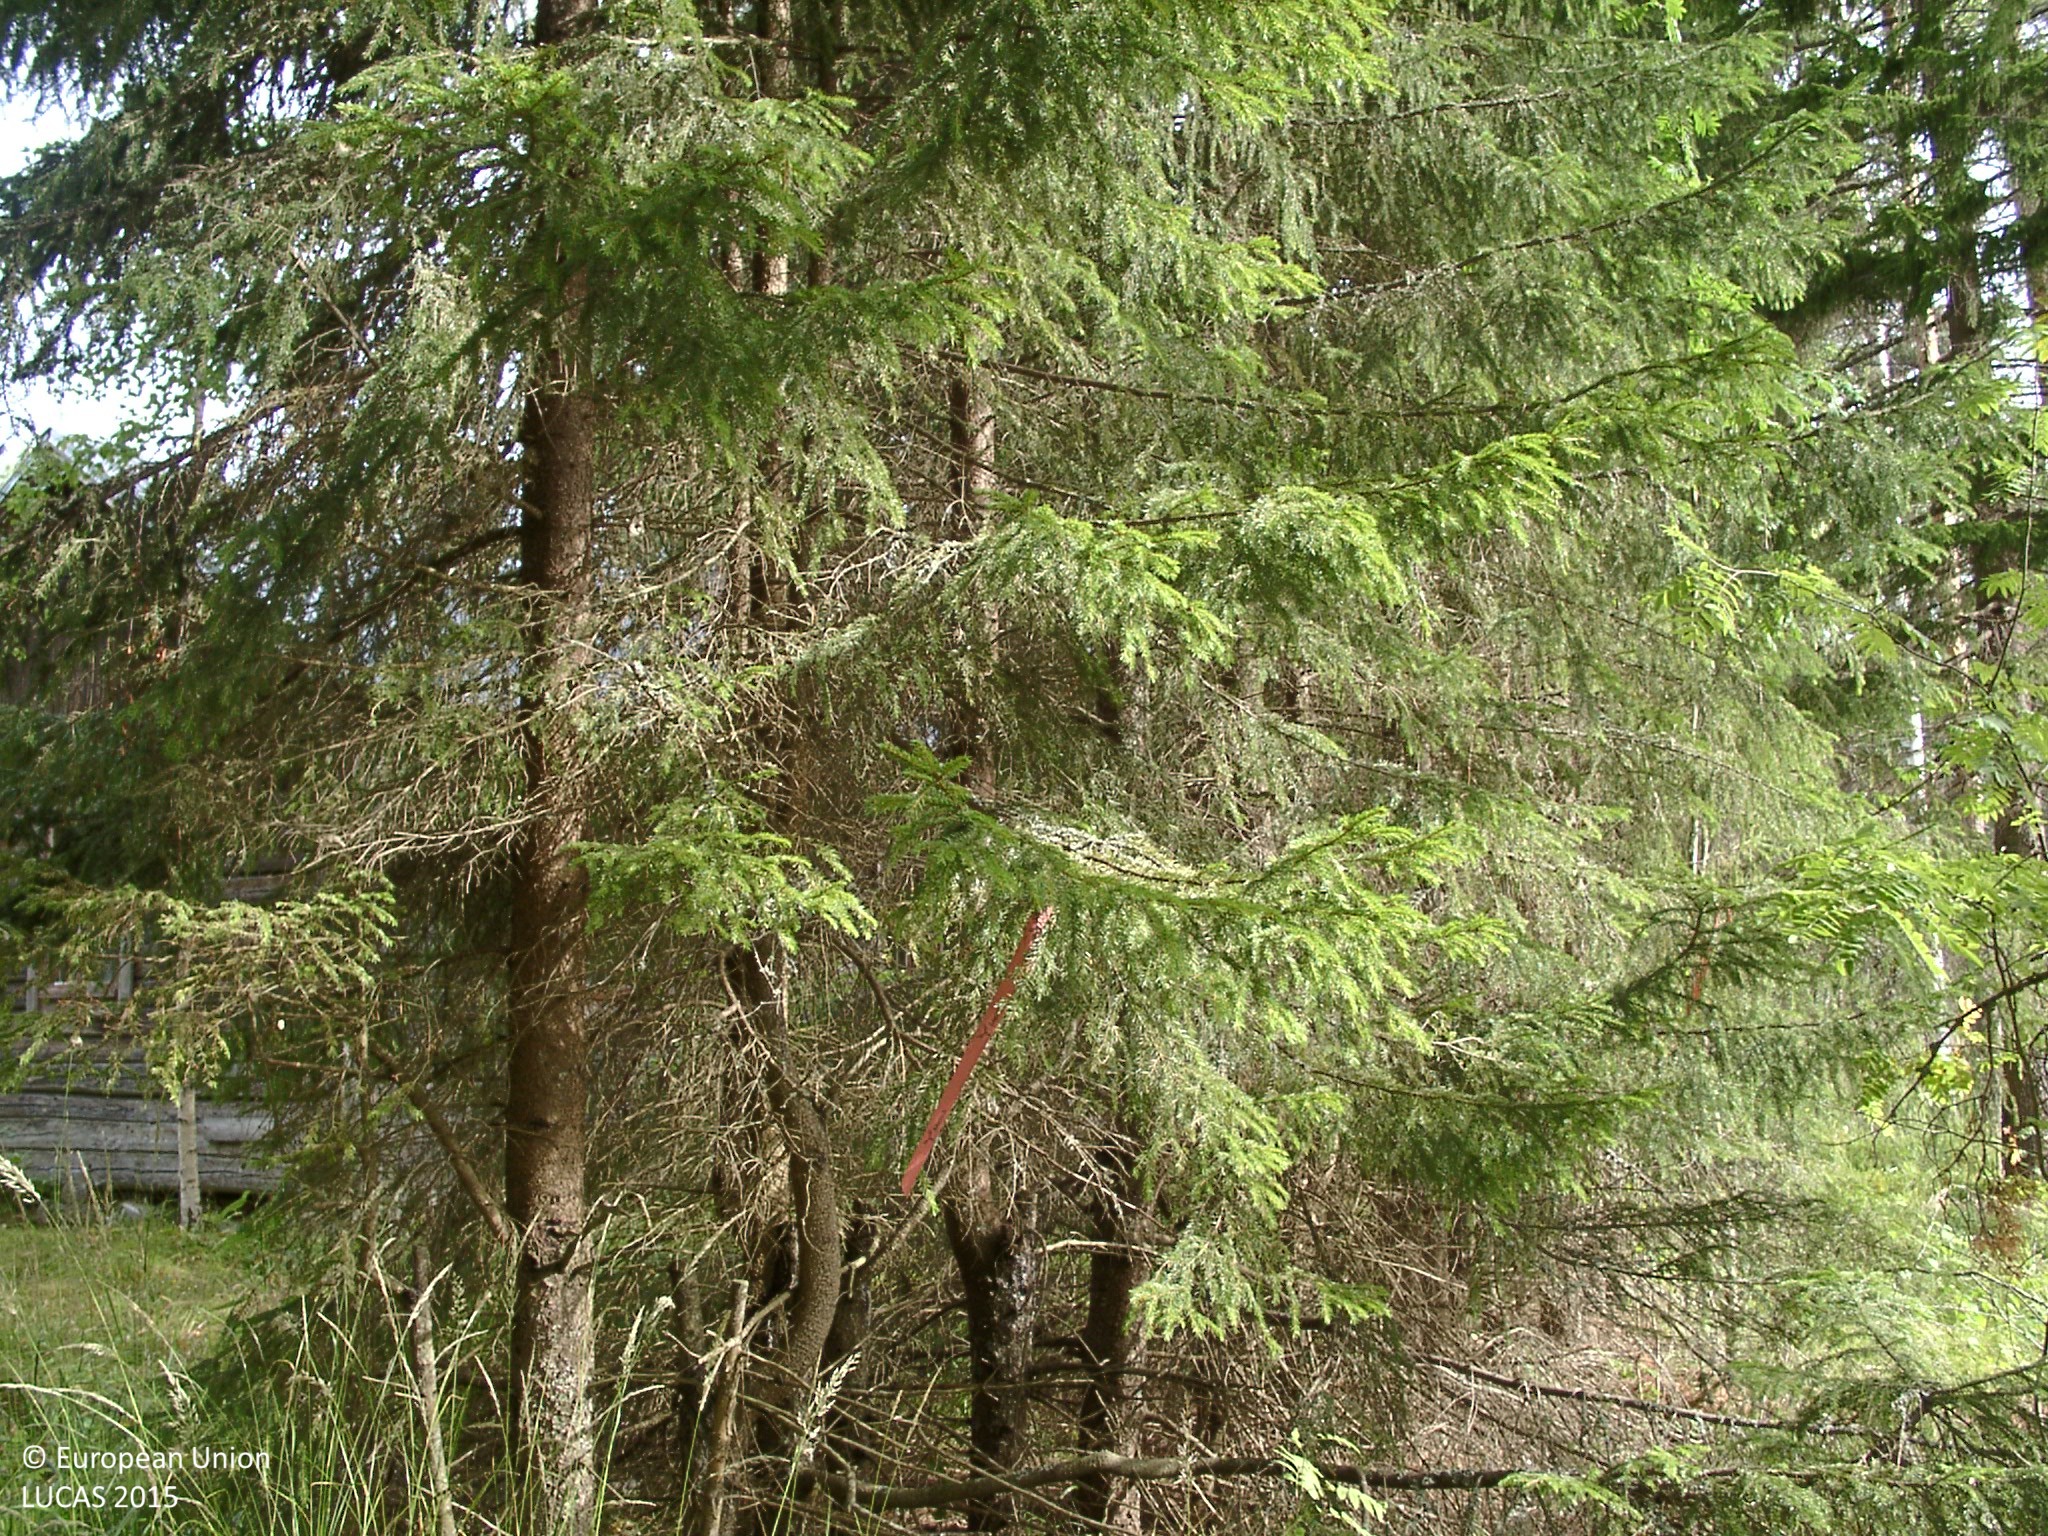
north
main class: Woodland
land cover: Pine dominated coniferous woodland
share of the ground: 50 - 75 %
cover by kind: coniferous forest trees 50 %, herbaceous plants 15 %, broadleaved forest trees 10 %, shrubs 10 %, lichens and mosses 5 %
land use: Forestry
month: August
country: FI
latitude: 61.8740
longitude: 25.3453
